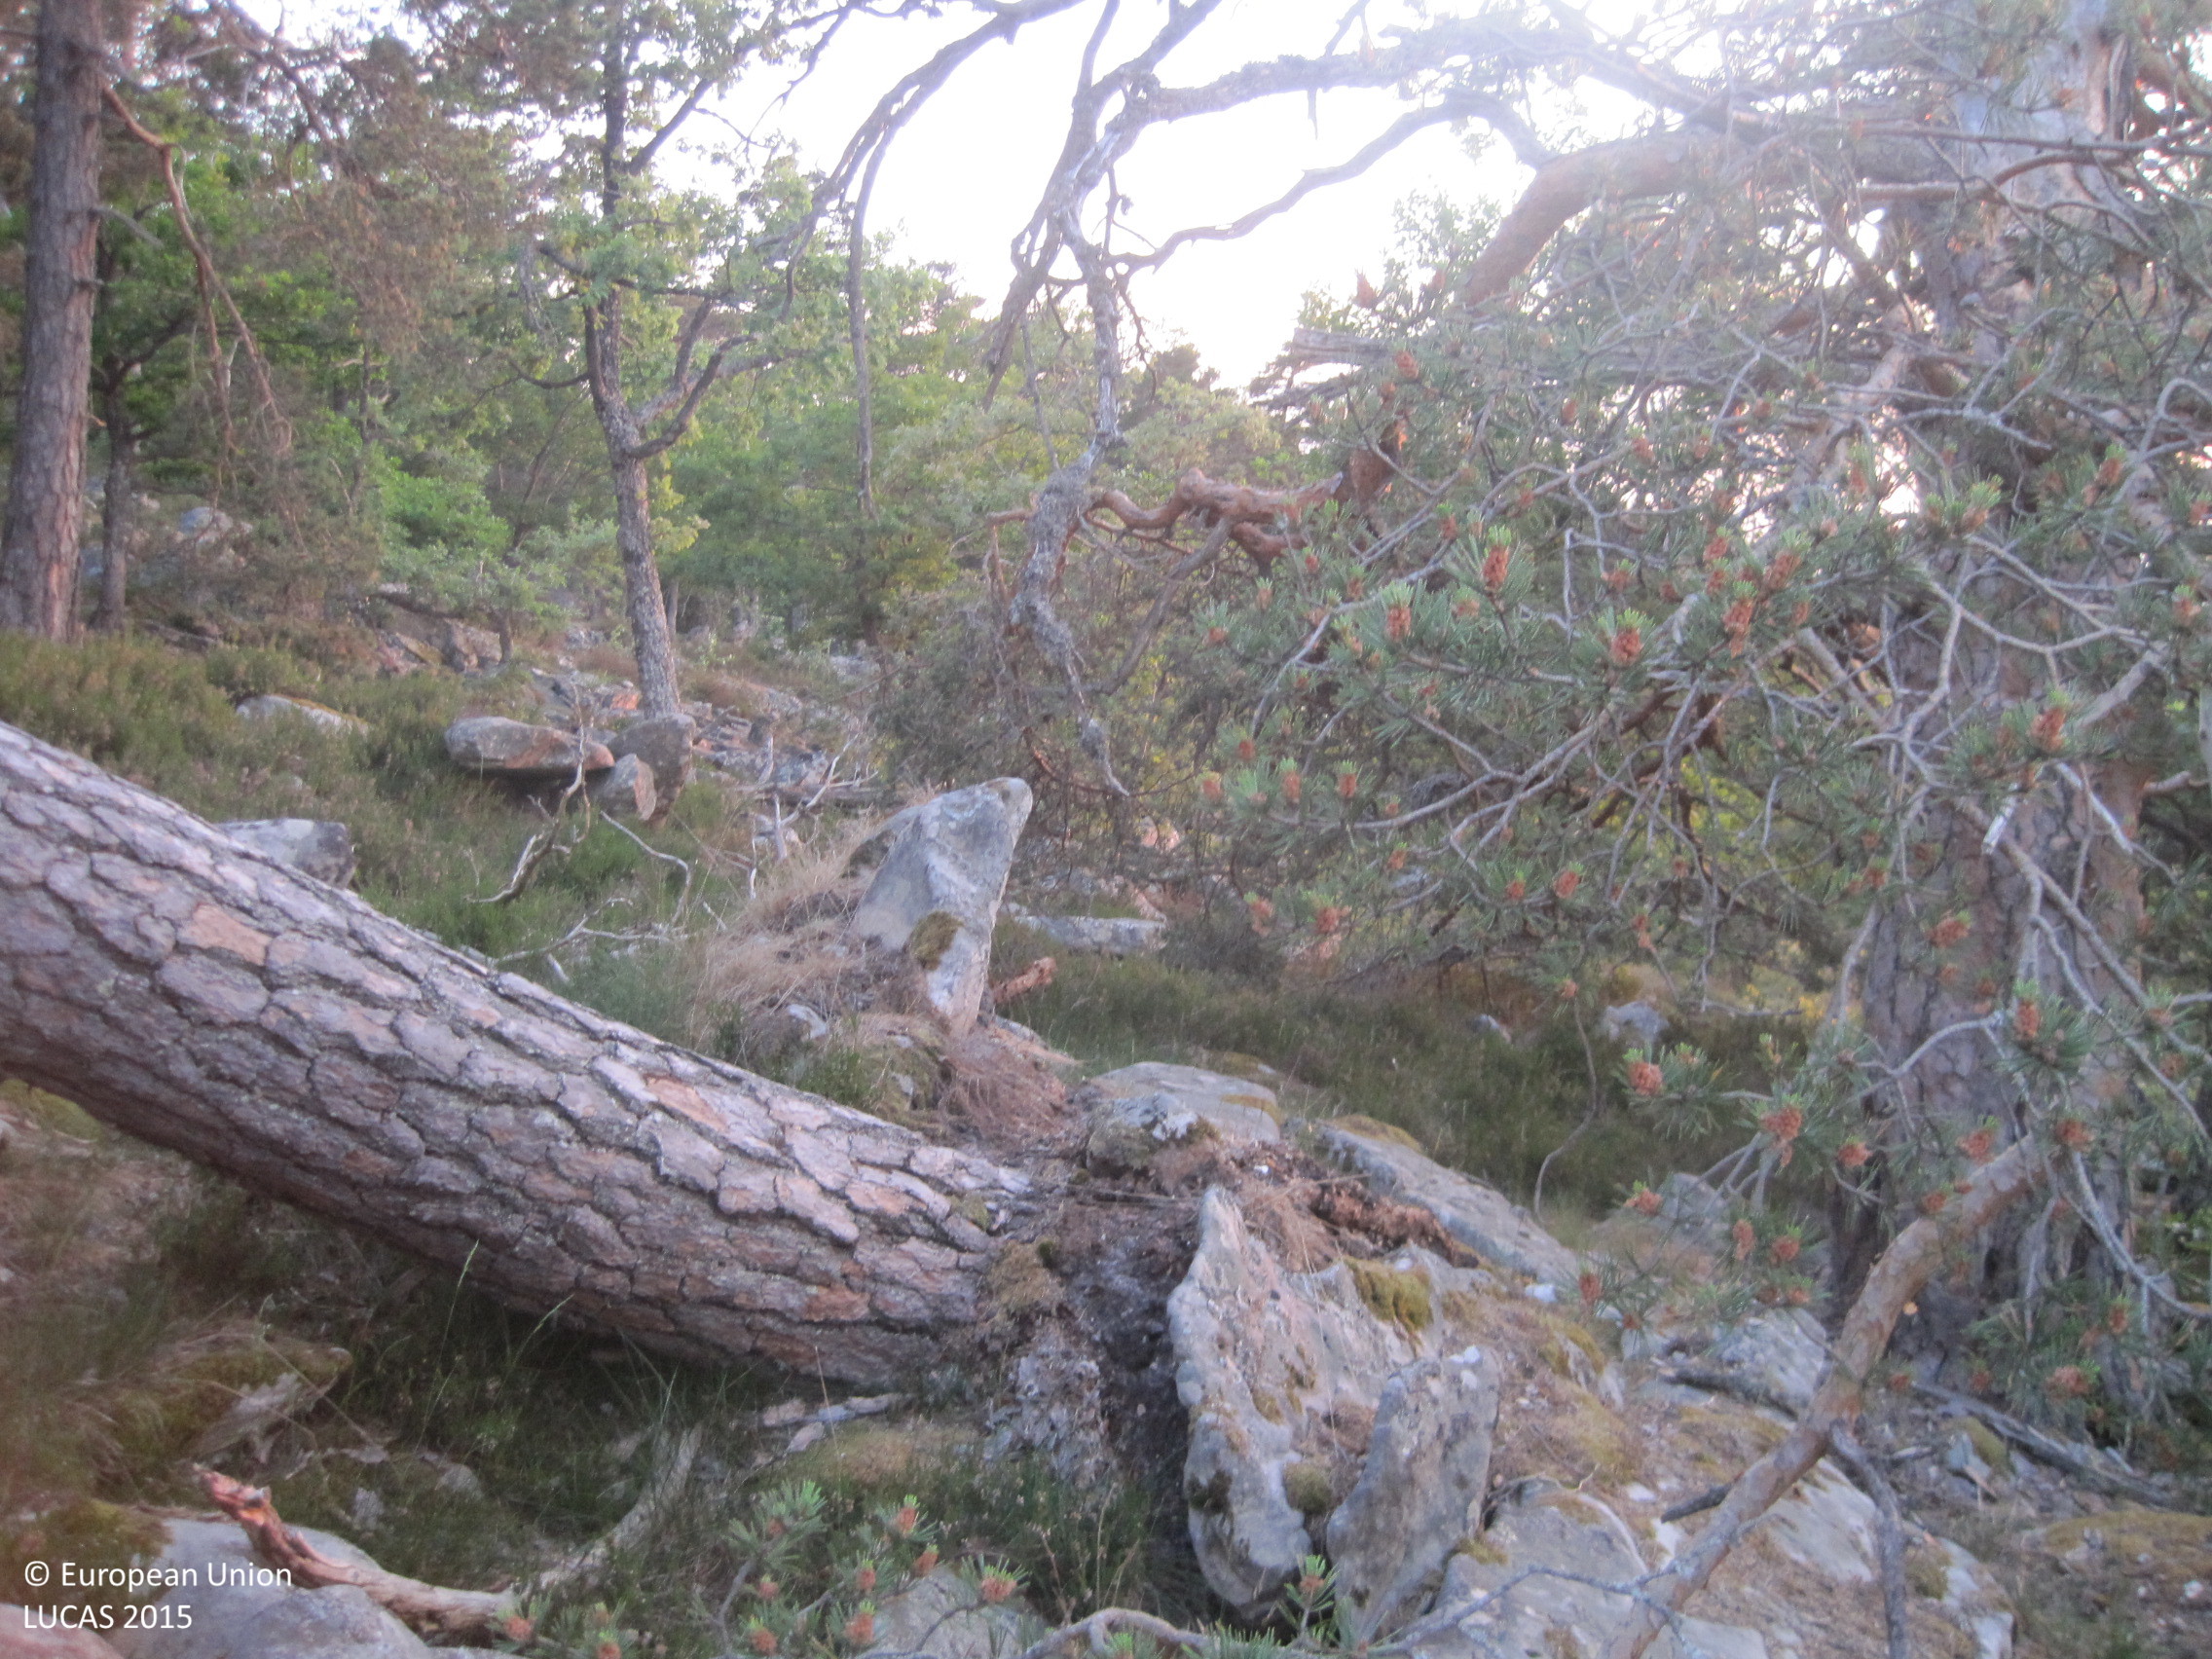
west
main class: Woodland
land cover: Pine dominated coniferous woodland
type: coniferous forest of the mediterranean region
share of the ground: > 75 %
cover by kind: coniferous forest trees 75 %, broadleaved forest trees 15 %, consolidated bare surface 10 %
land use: Forestry
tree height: > 5 m
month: June
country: ES
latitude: 42.6561
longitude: -1.1461
